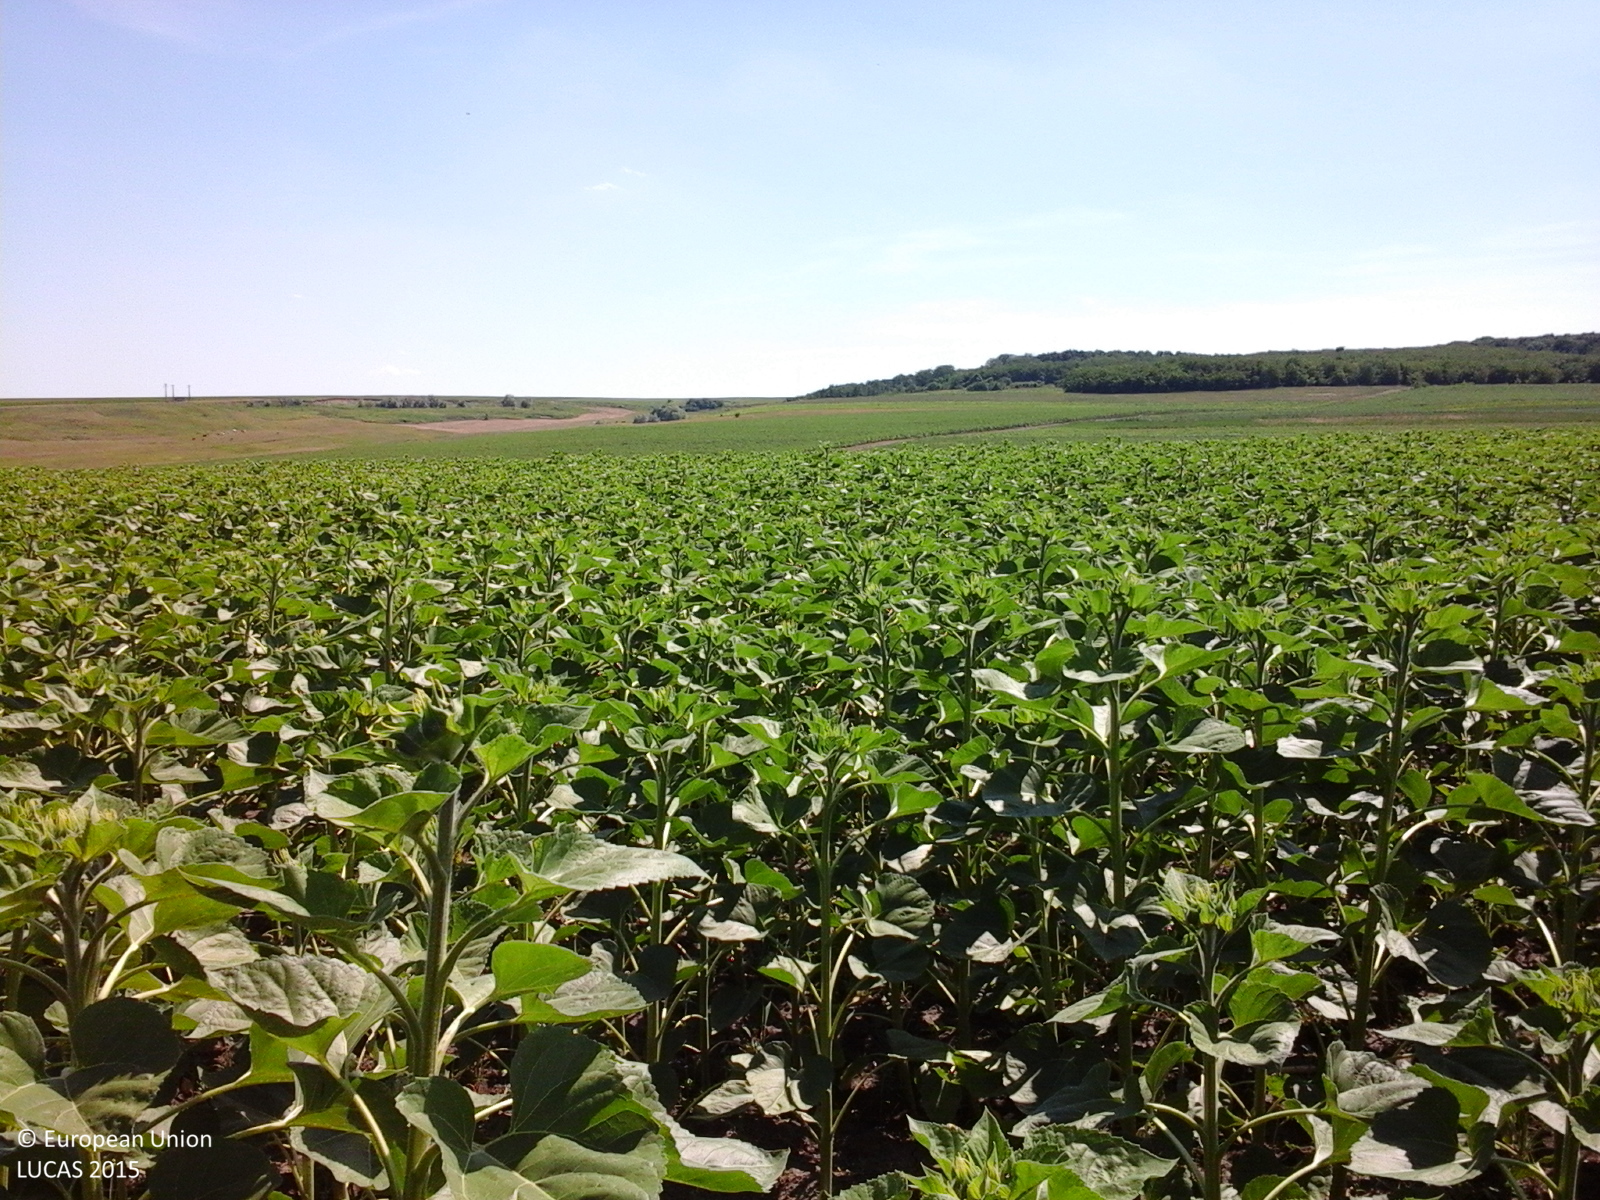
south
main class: Cropland
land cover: Sunflower
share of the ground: > 75 %
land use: Agriculture (excluding fallow land and kitchen gardens)
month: June
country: RO
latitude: 48.0881
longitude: 26.9822
